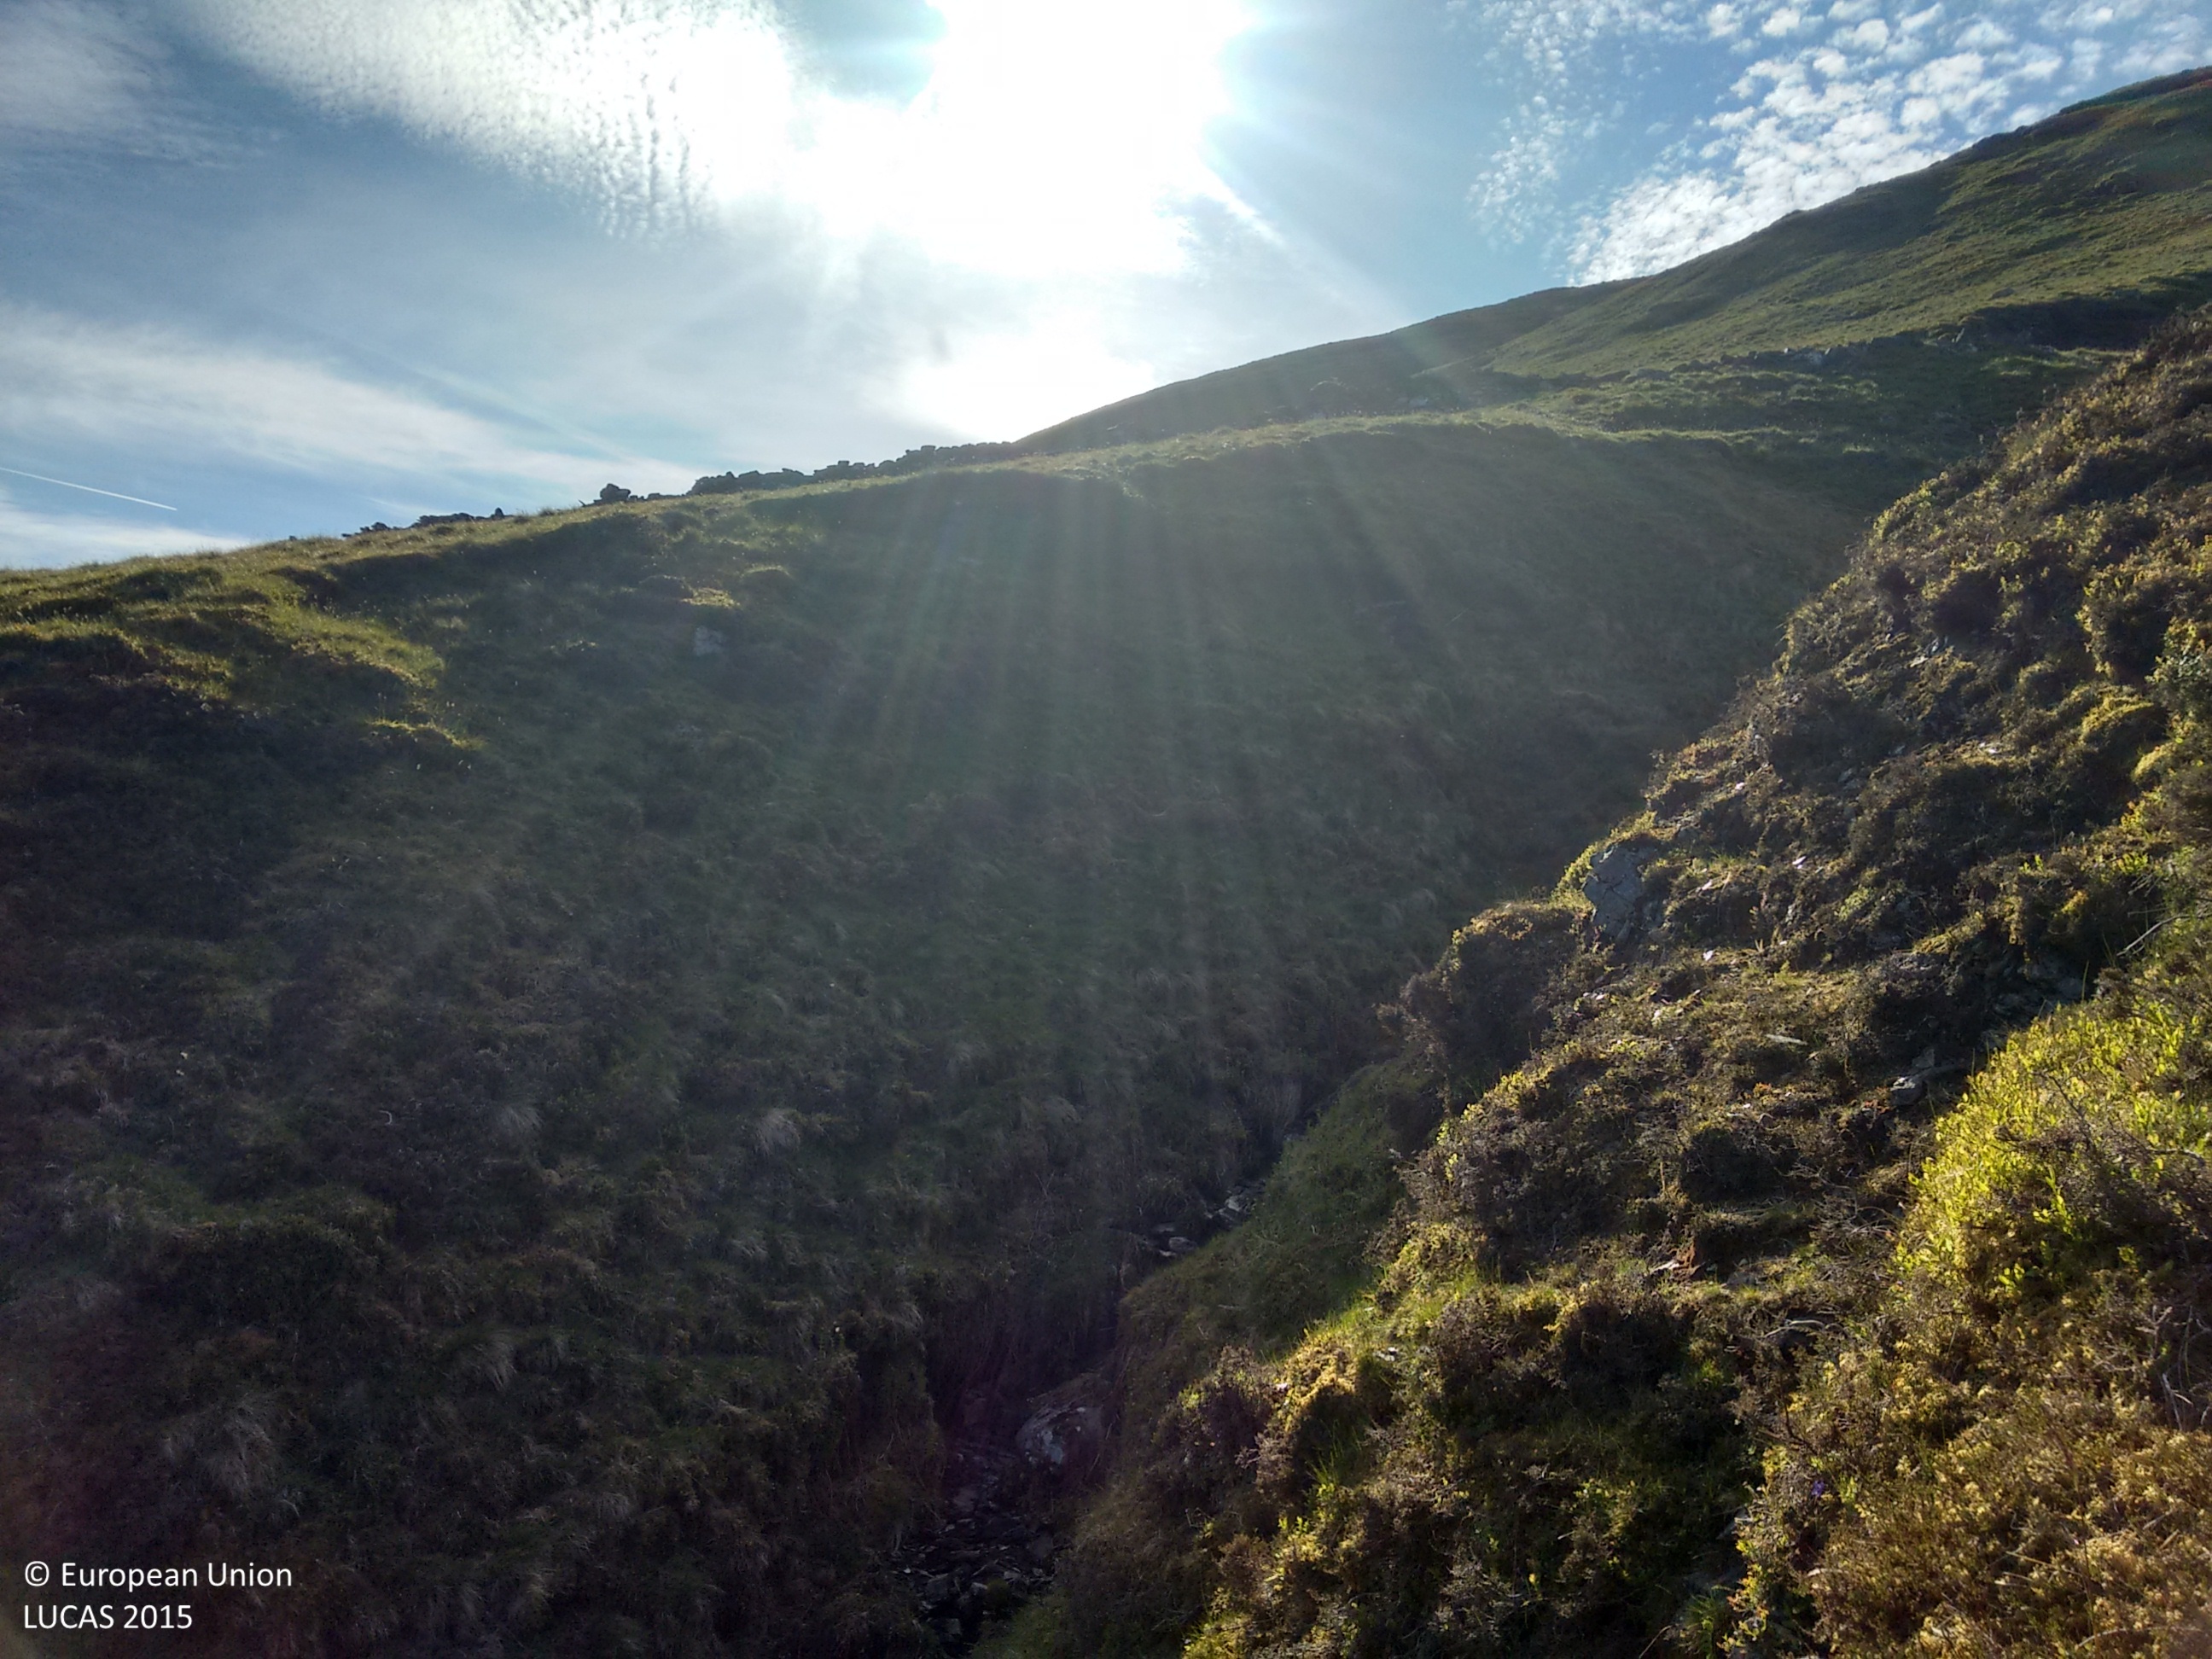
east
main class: Grassland
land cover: Grassland without tree/shrub cover
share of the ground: > 75 %
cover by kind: herbaceous plants 90 %, shrubs 5 %
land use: Agriculture (excluding fallow land and kitchen gardens)
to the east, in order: Grassland without tree/shrub cover; Rivers and streams; Grassland without tree/shrub cover; Dry stone walls; Grassland without tree/shrub cover; Shrubland without tree cover
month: June
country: GB
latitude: 56.5178
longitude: -4.1137
